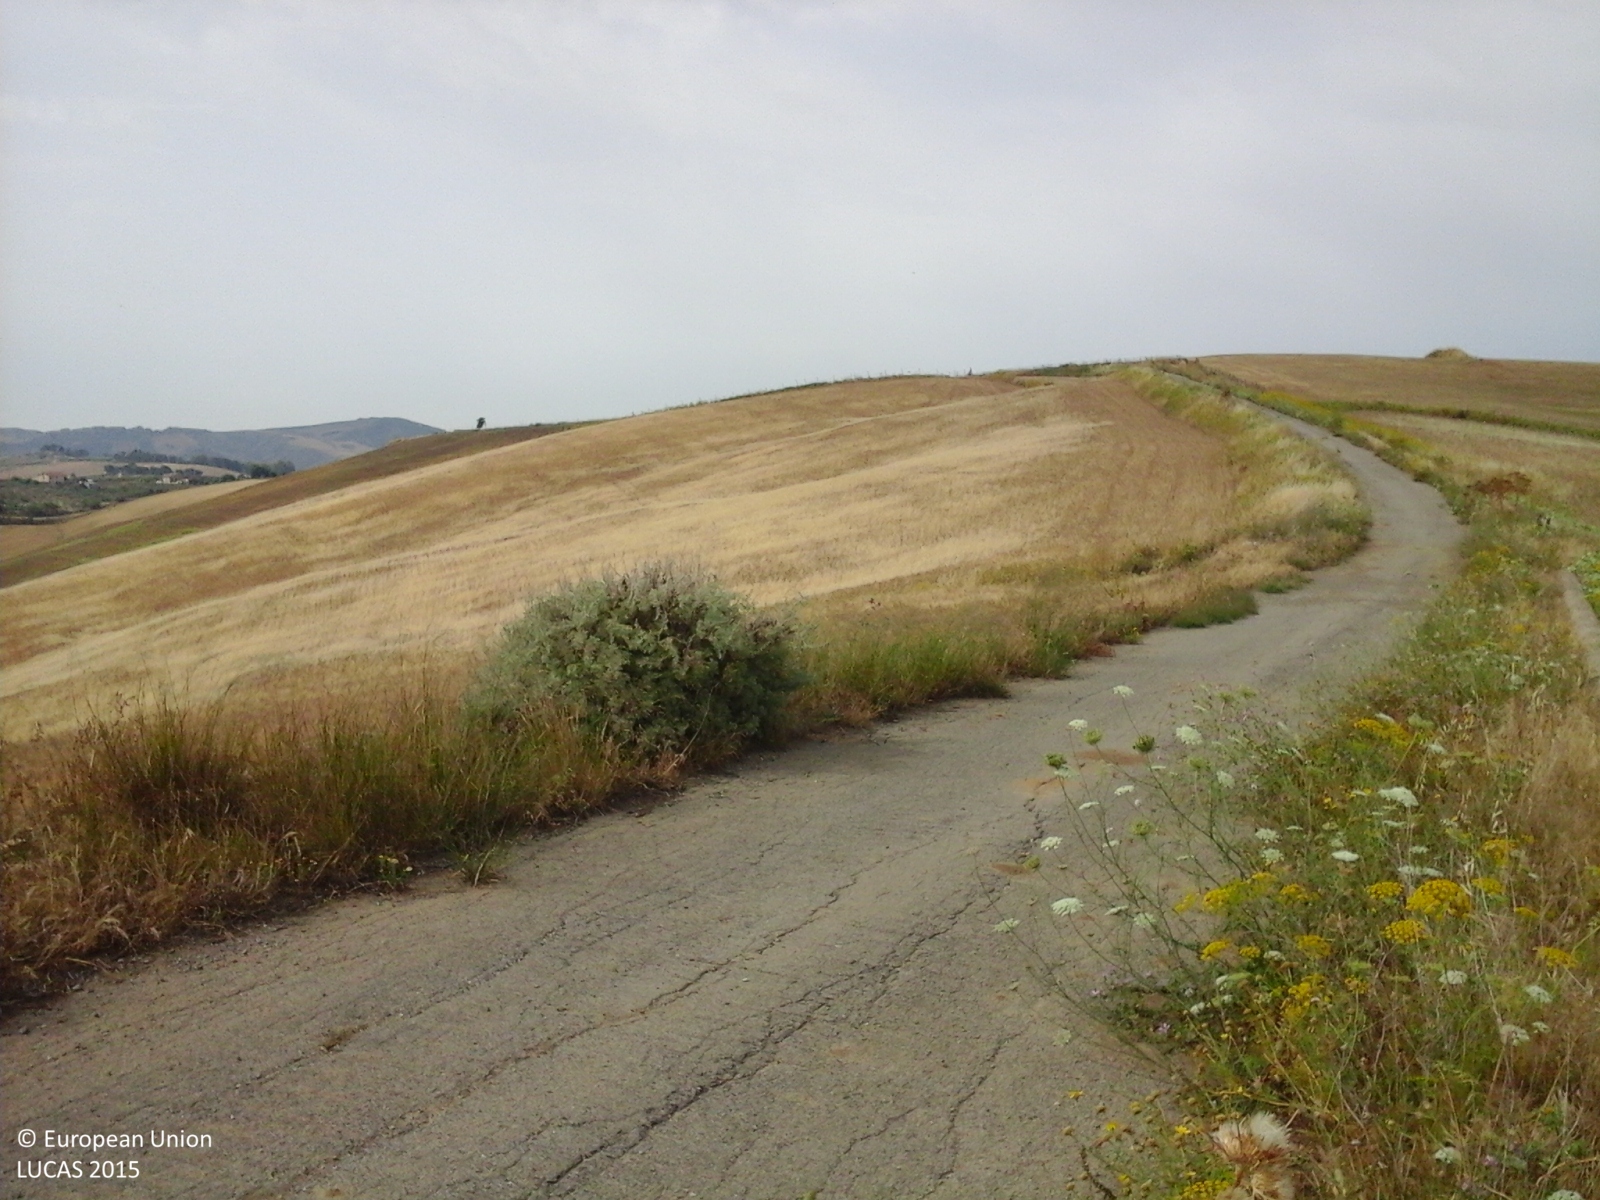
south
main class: Cropland
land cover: Durum wheat
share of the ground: > 75 %
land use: Agriculture (excluding fallow land and kitchen gardens)
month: June
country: IT
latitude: 37.4441
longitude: 14.0274
